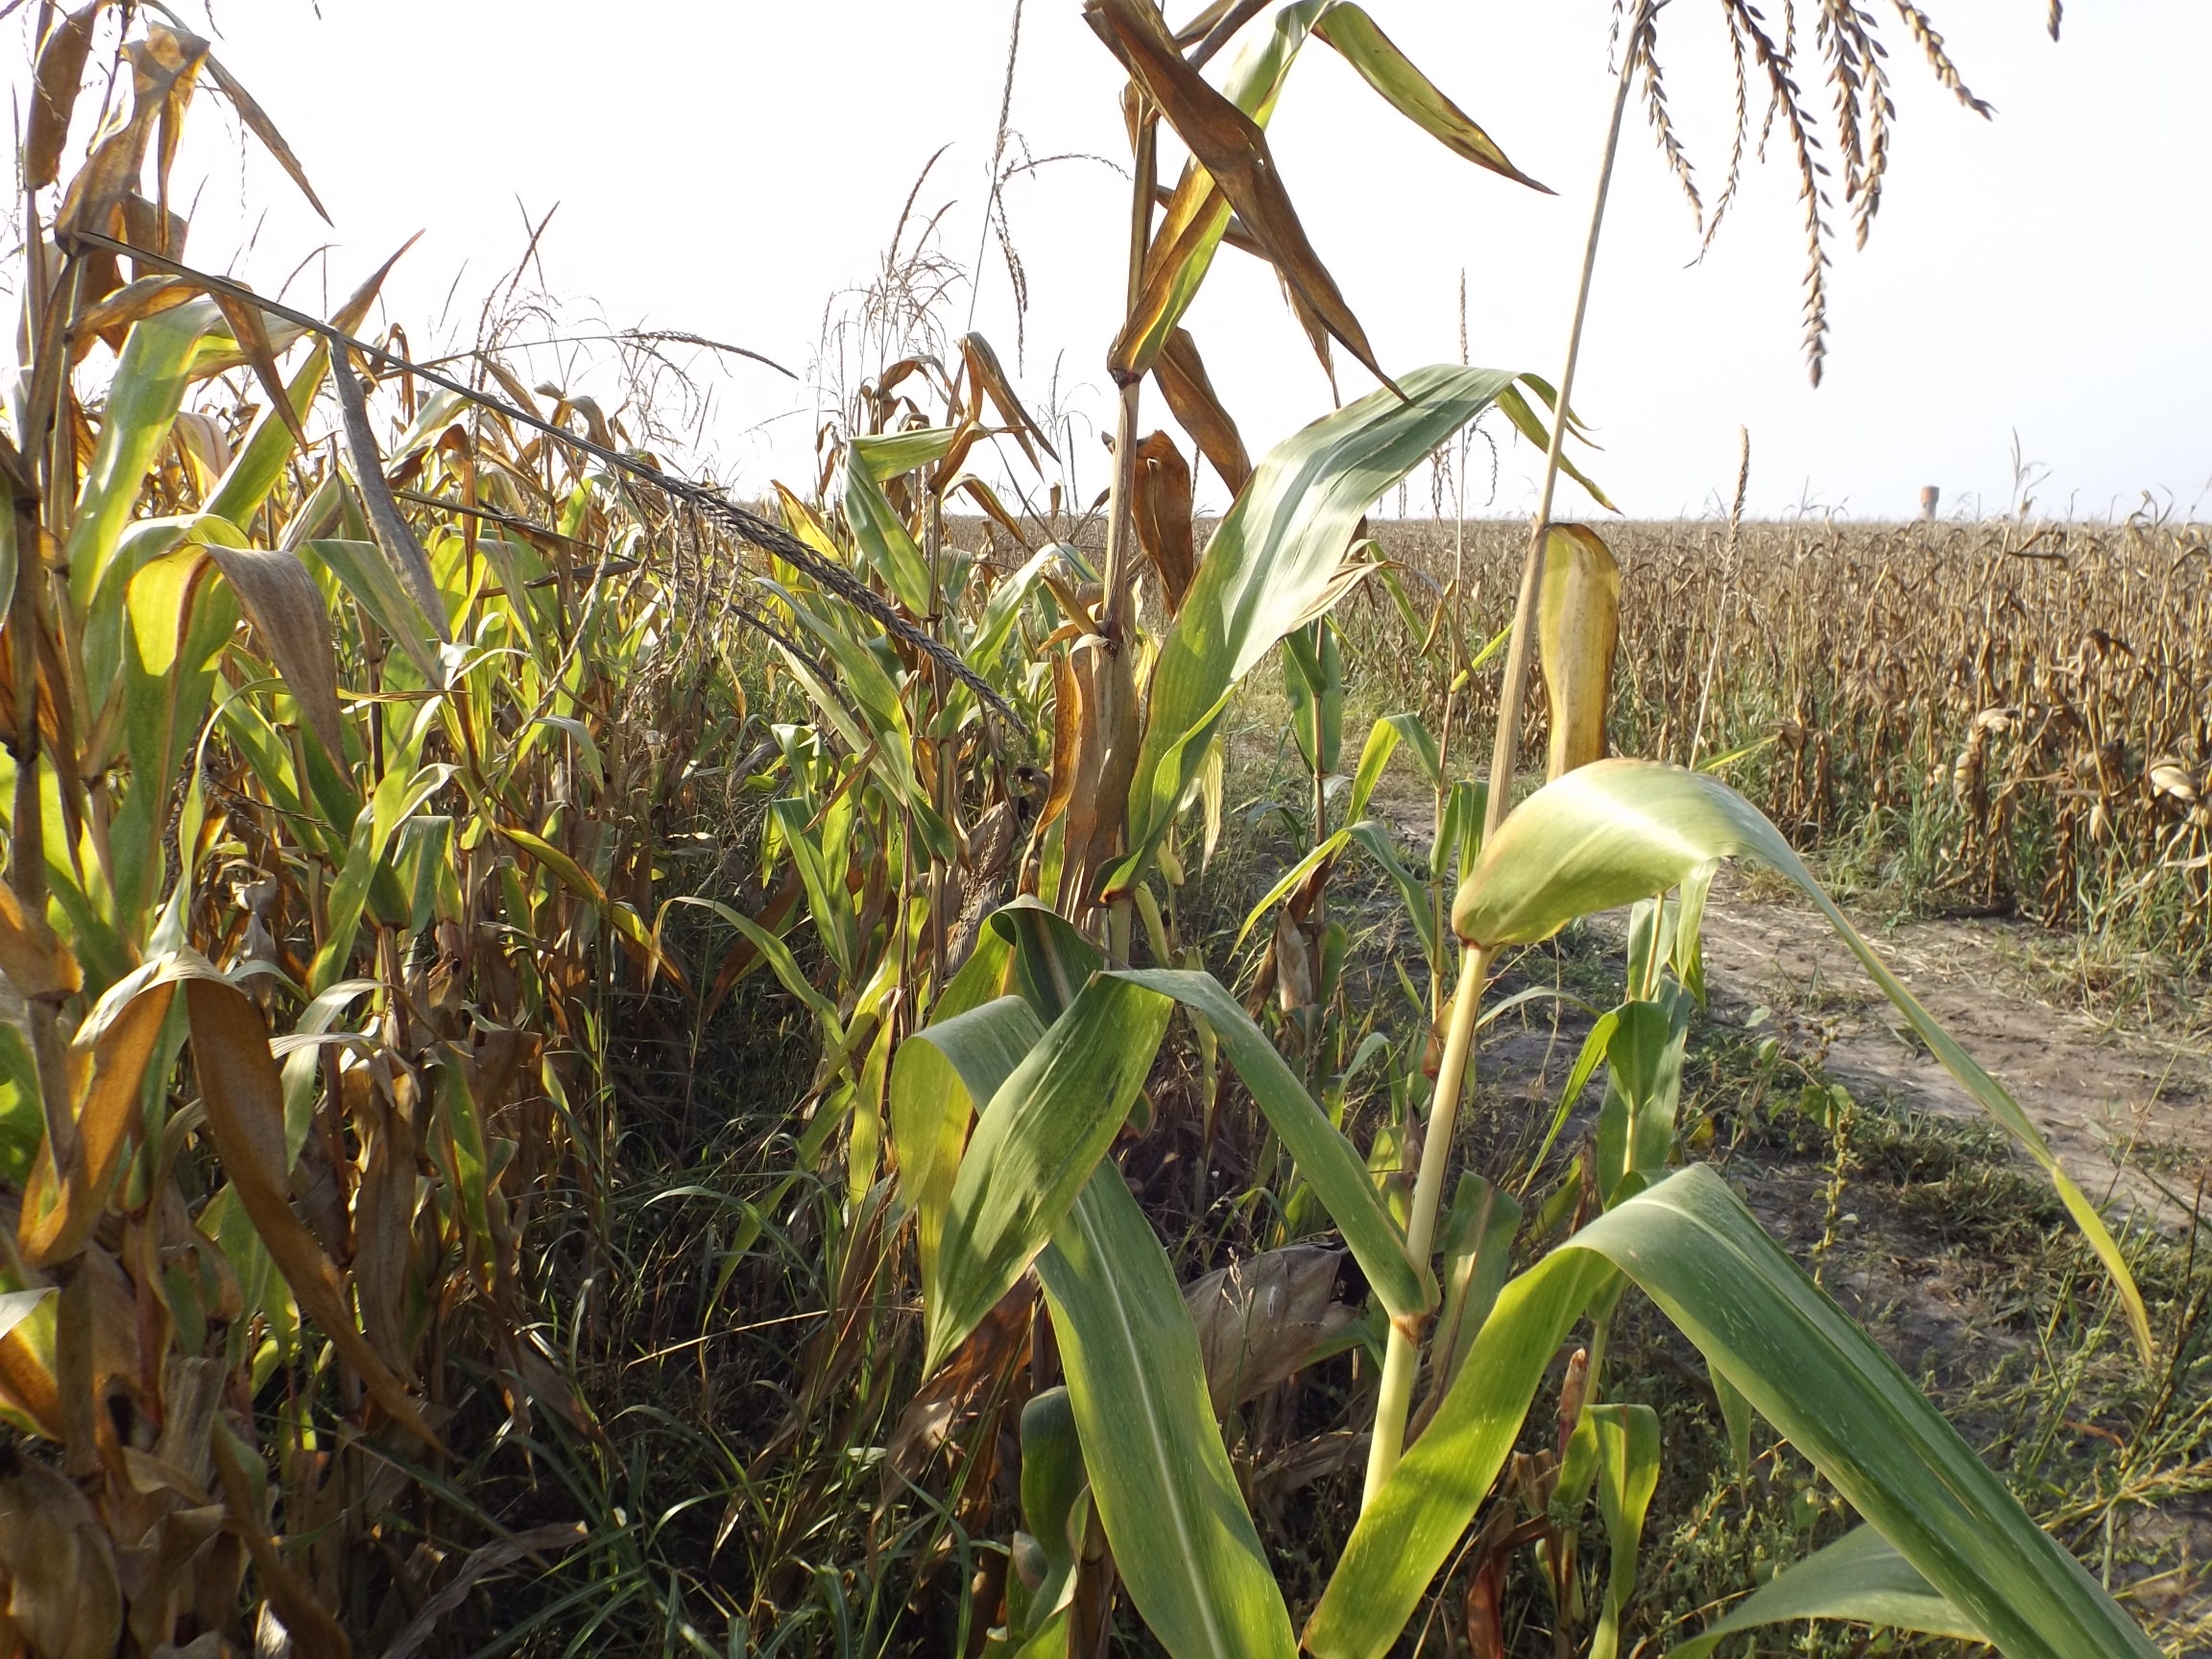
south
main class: Cropland
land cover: Maize
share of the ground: > 75 %
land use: Agriculture (excluding fallow land and kitchen gardens)
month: September
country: BG
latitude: 44.0073
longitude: 26.4096
